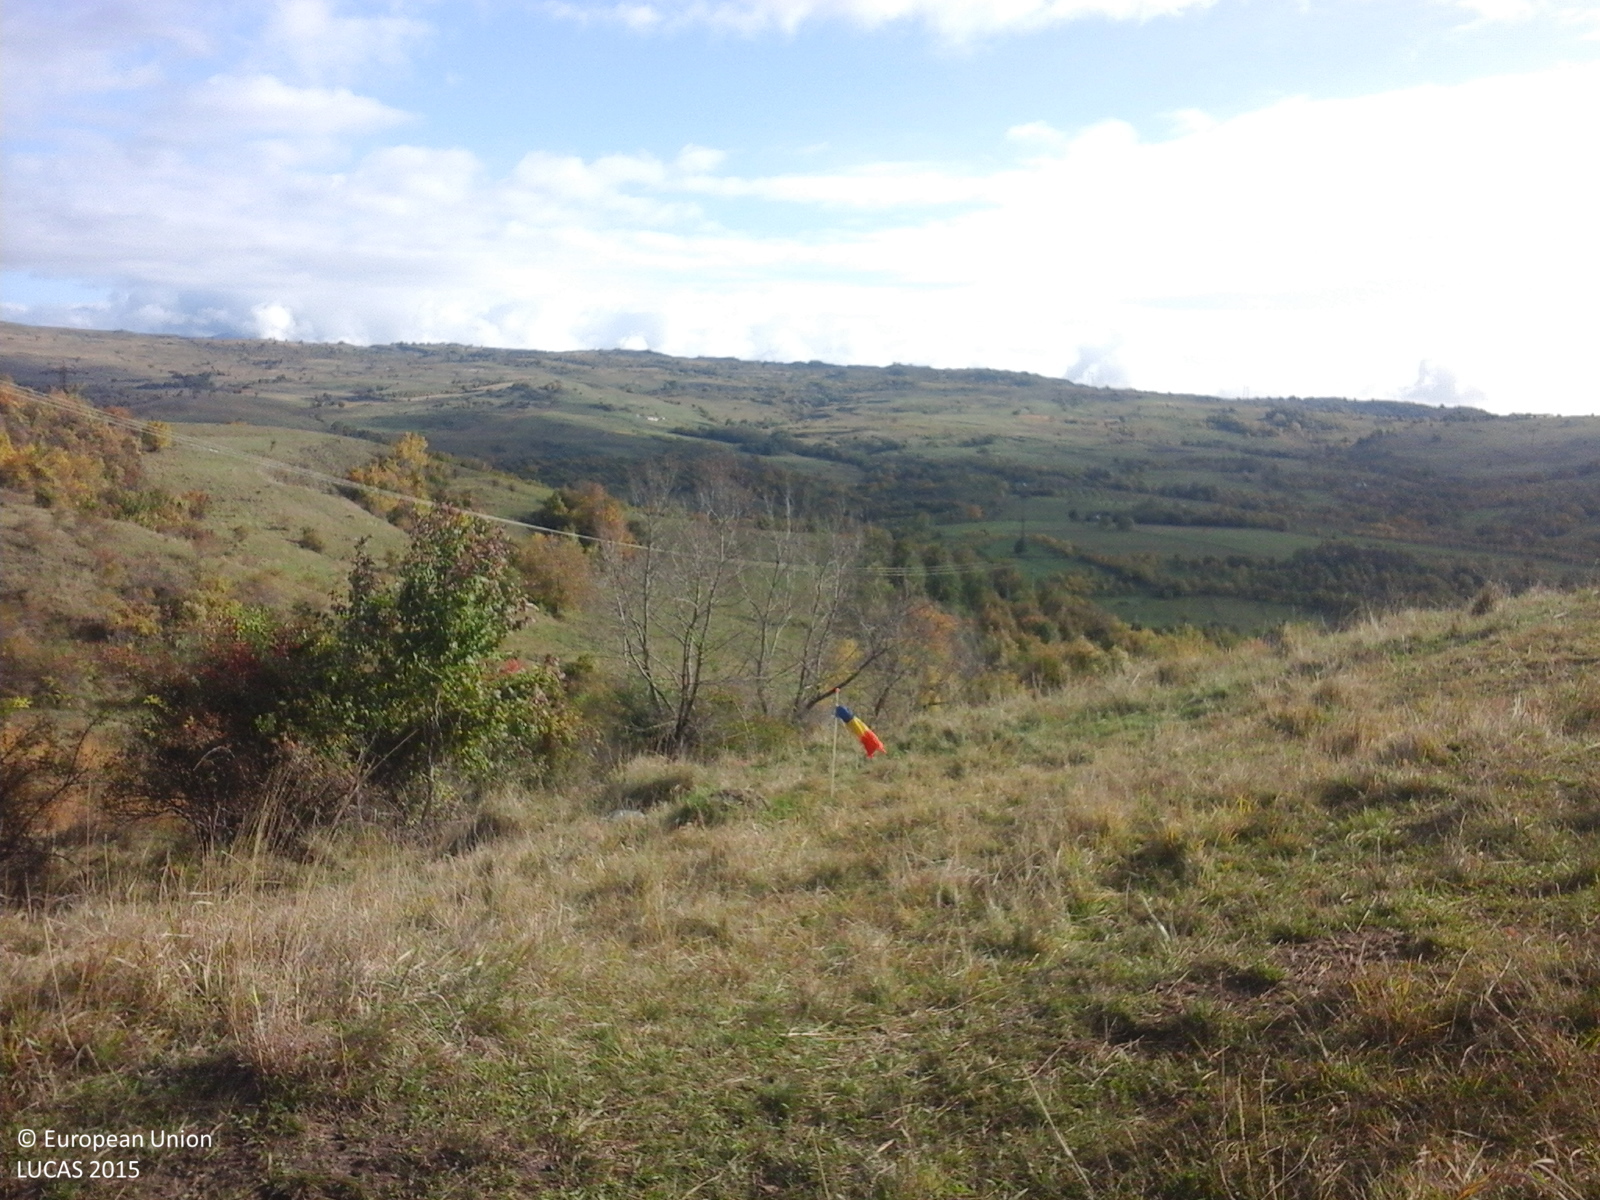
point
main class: Grassland
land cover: Grassland without tree/shrub cover
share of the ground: > 75 %
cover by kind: herbaceous plants 100 %
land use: Agriculture (excluding fallow land and kitchen gardens)
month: October
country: RO
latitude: 45.1949
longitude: 25.1229
